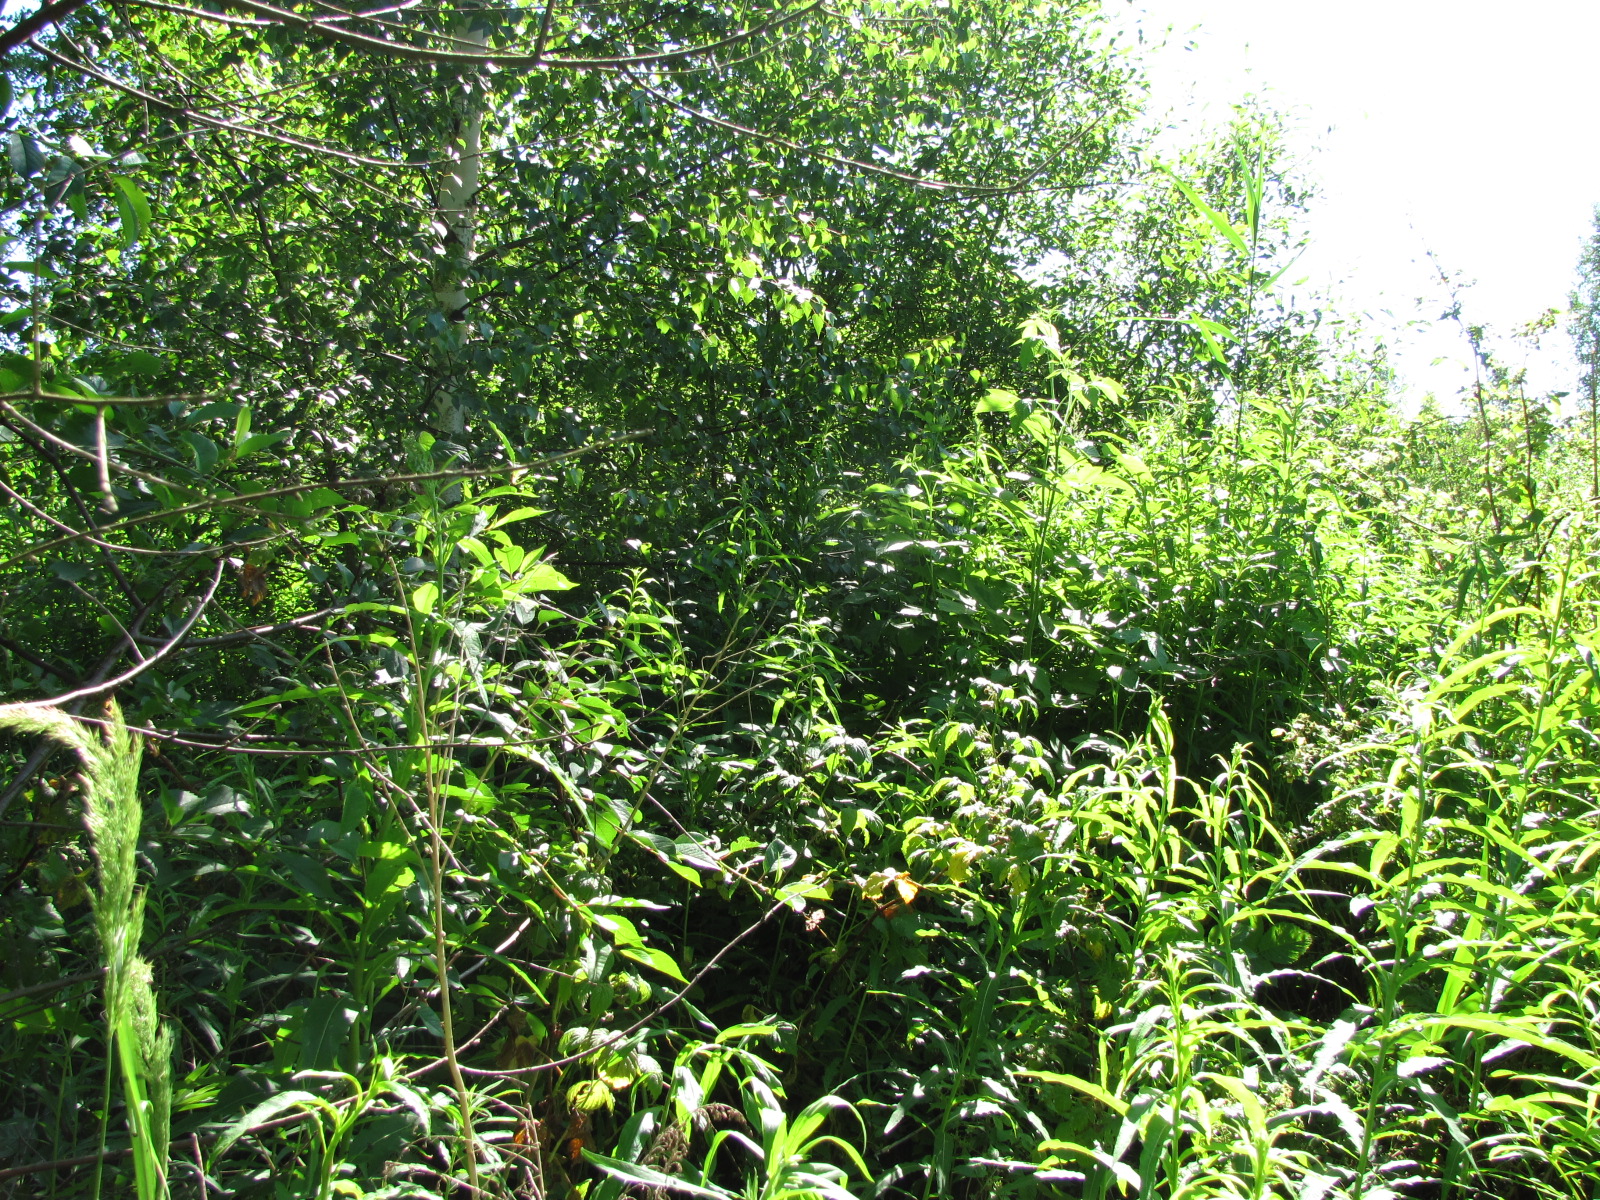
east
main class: Woodland
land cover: Broadleaved woodland
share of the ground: 25 - 50 %
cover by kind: herbaceous plants 55 %, broadleaved forest trees 45 %
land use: Abandoned areas
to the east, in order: Broadleaved woodland; Artificial constructions in urban areas
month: July
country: LV
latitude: 56.8622
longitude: 24.1431
